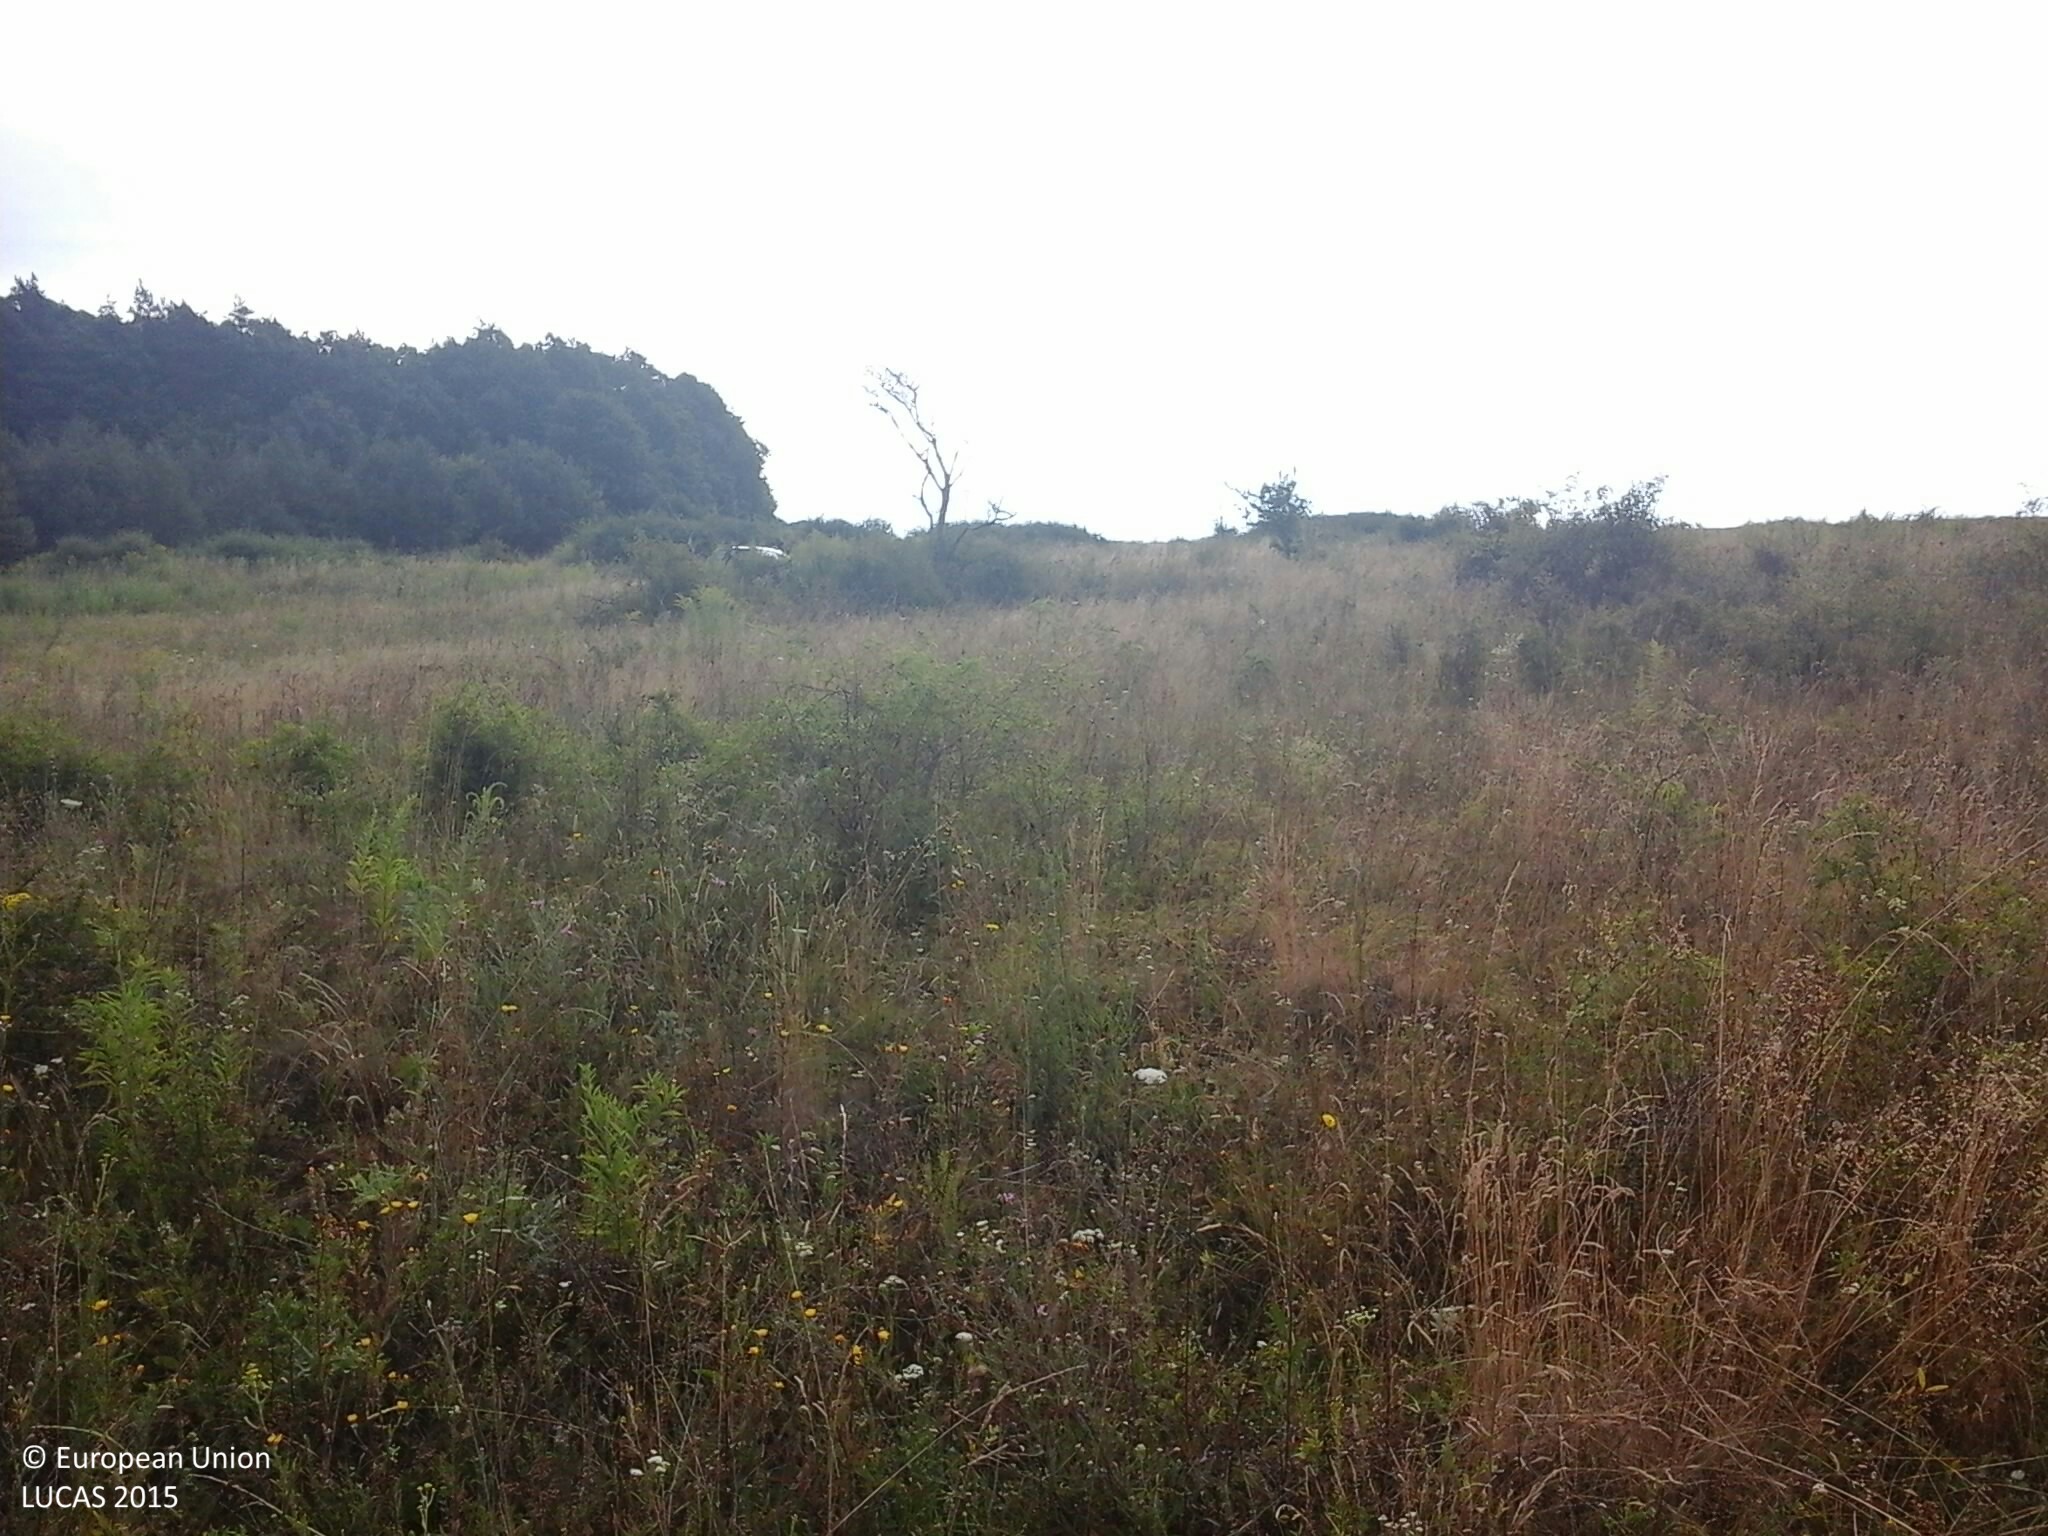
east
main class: Grassland
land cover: Grassland without tree/shrub cover
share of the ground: > 75 %
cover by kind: herbaceous plants 95 %, shrubs 5 %
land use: Agriculture (excluding fallow land and kitchen gardens)
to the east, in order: Grassland without tree/shrub cover; Abandoned hedges; Grassland without tree/shrub cover; Tracks; Spontaneously vegetated surfaces; Shrubland without tree cover; Spontaneously vegetated surfaces
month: July
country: HU
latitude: 48.4886
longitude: 21.1786
